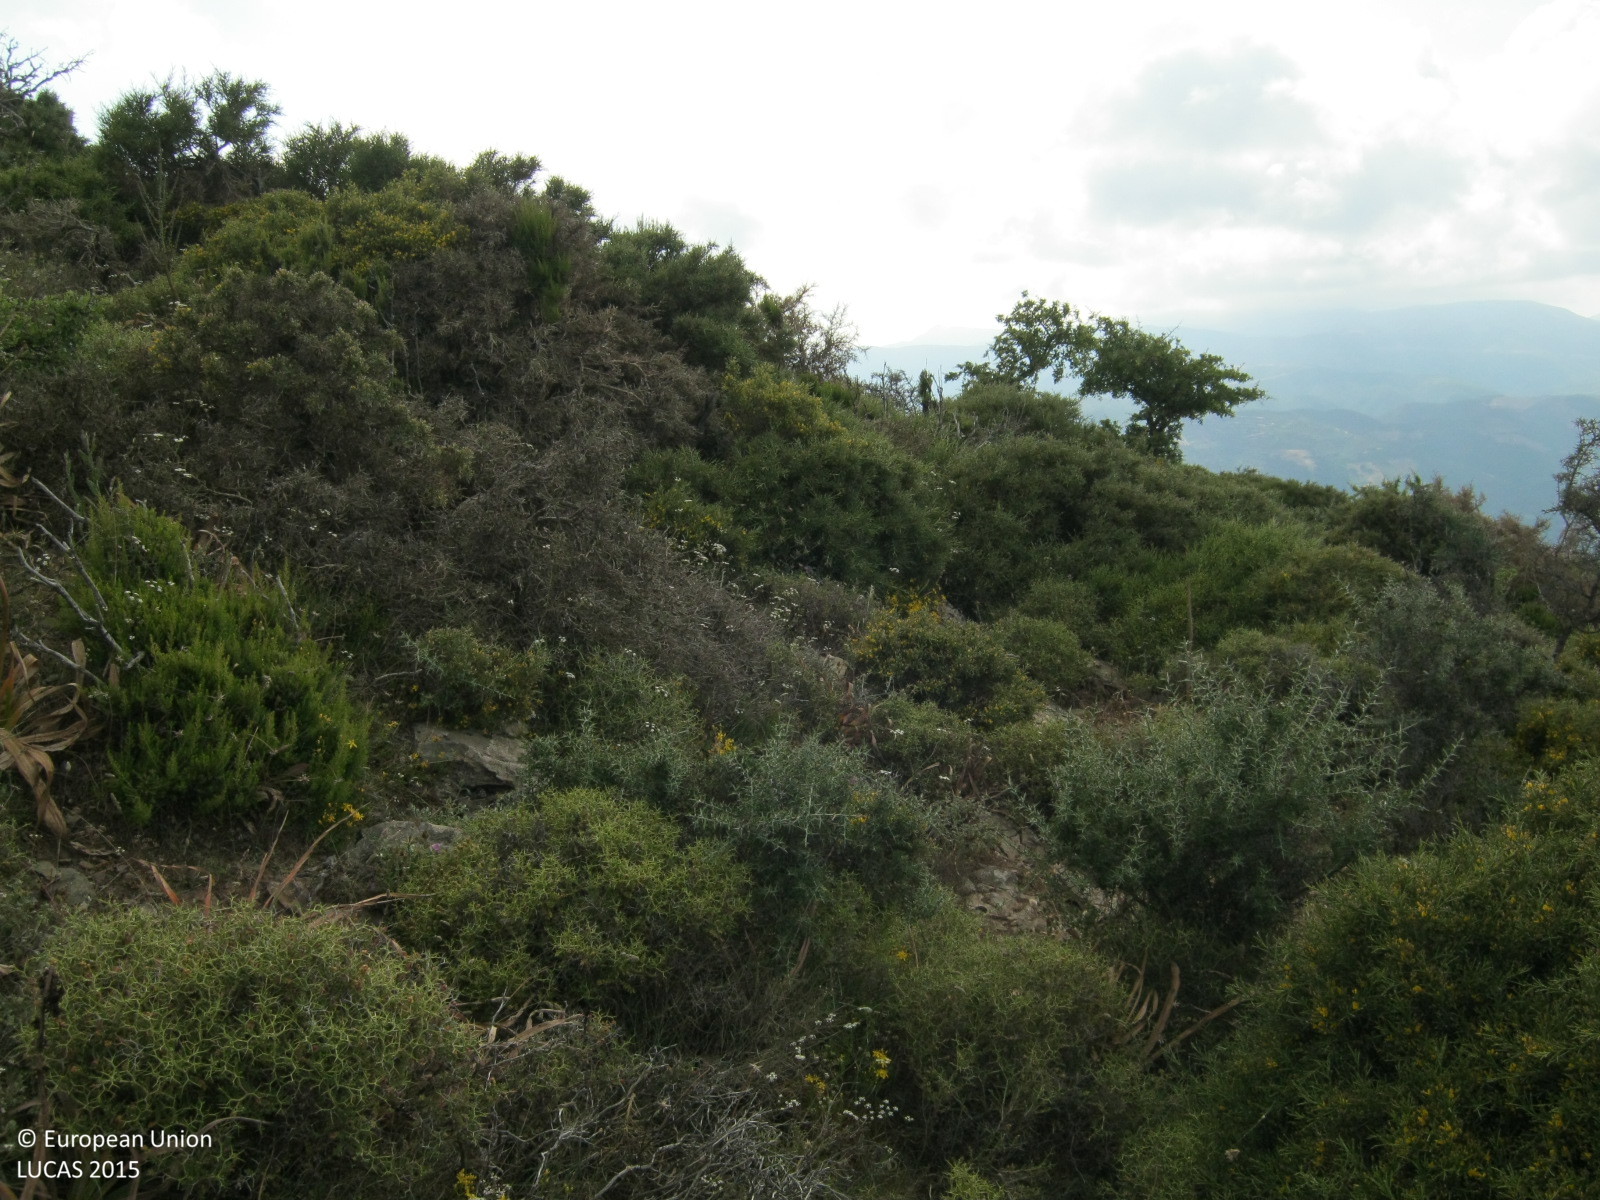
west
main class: Shrubland
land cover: Shrubland with sparse tree cover
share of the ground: > 75 %
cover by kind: shrubs 70 %, unconsolidated bare surface 15 %, herbaceous plants 10 %, broadleaved forest trees 5 %
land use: Agriculture (excluding fallow land and kitchen gardens)
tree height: < 5 m
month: June
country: GR
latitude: 35.3111
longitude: 23.7393
